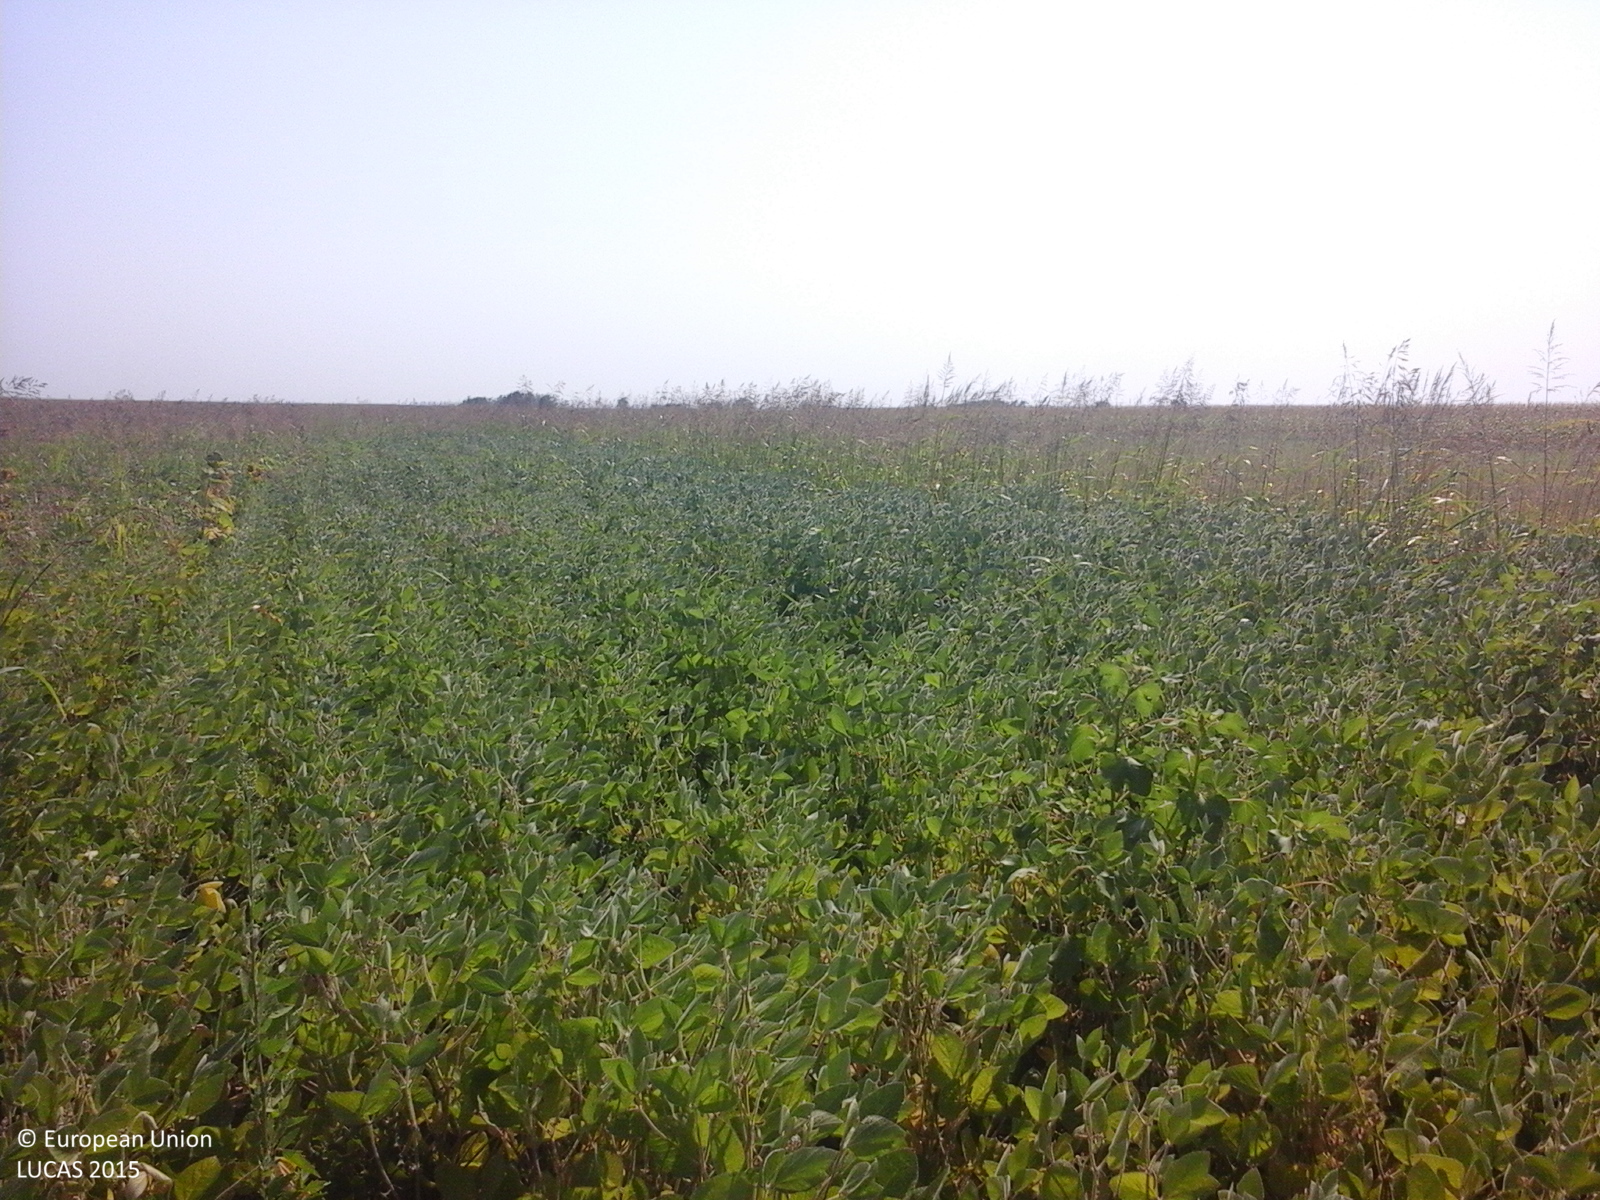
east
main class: Cropland
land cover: Soya
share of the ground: > 75 %
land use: Agriculture (excluding fallow land and kitchen gardens)
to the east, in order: Soya; Grass margins; Common wheat; Maize
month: August
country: RO
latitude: 45.0966
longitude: 27.3899
